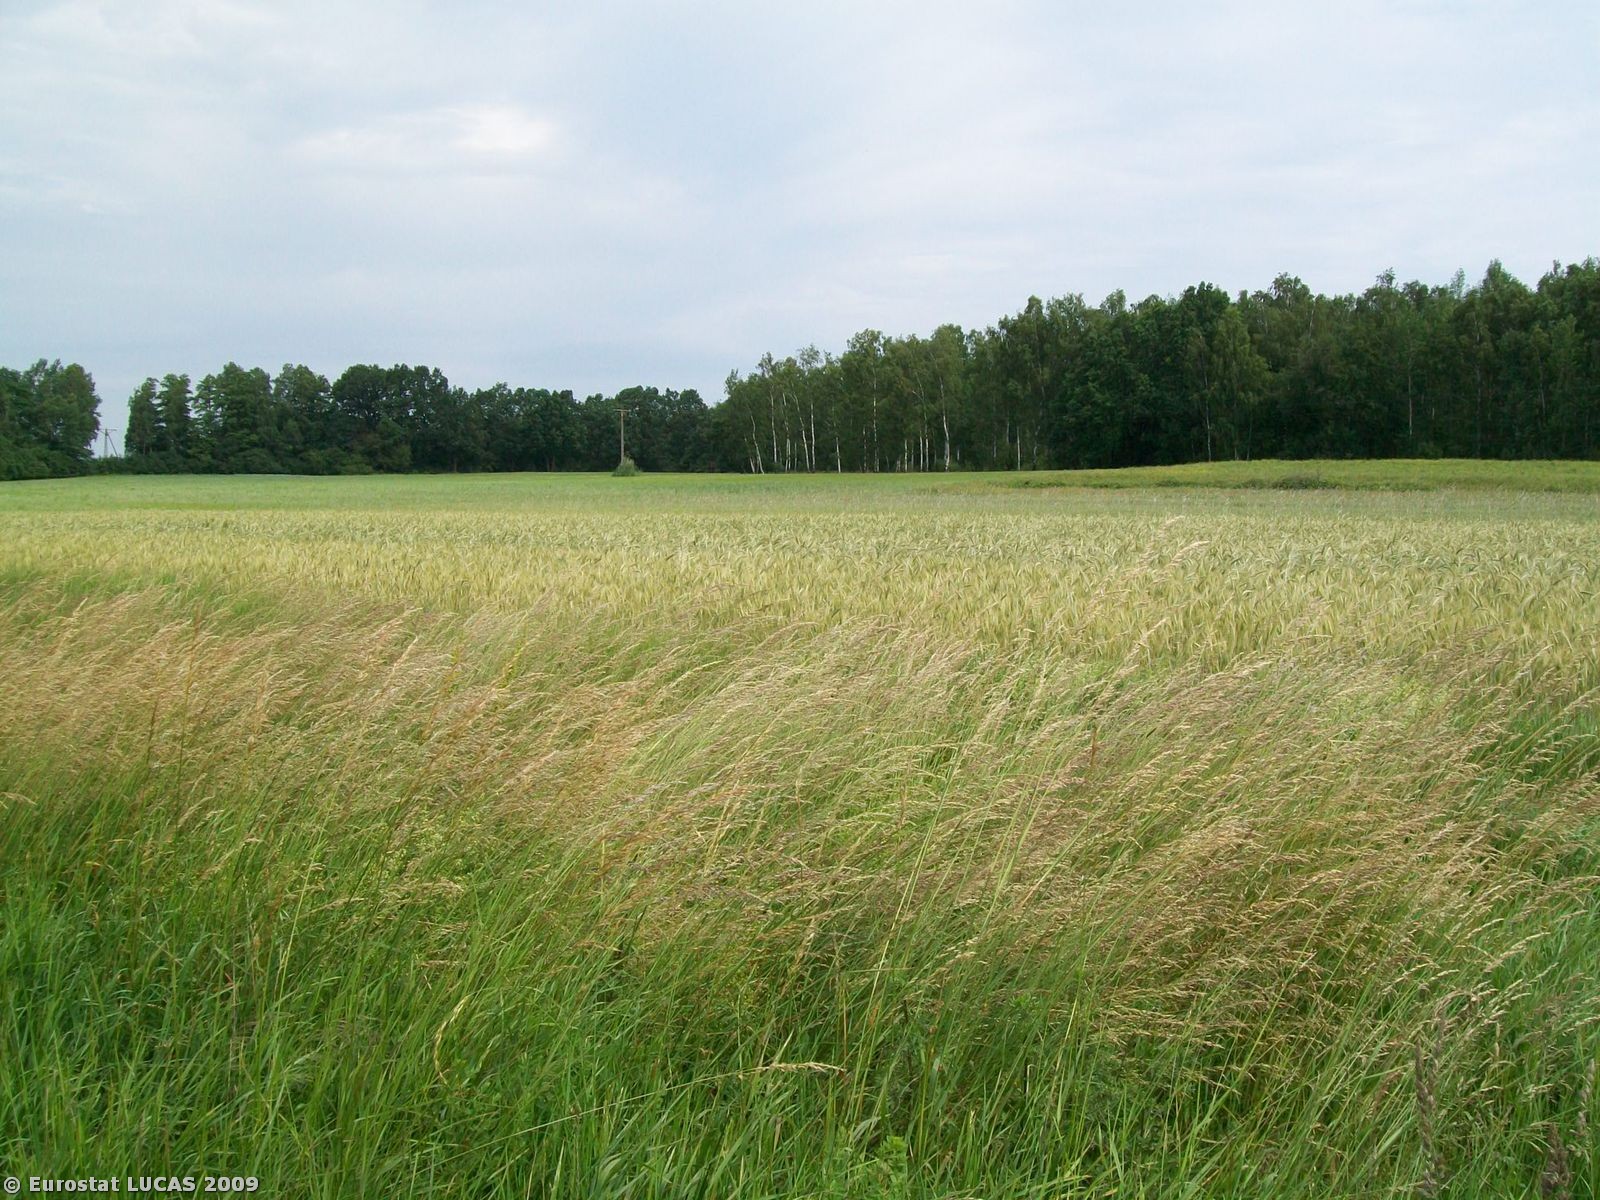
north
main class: Cropland
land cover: Barley
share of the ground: > 75 %
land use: Agriculture (excluding fallow land and kitchen gardens)
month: June
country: PL
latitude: 51.7052
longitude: 15.1983
